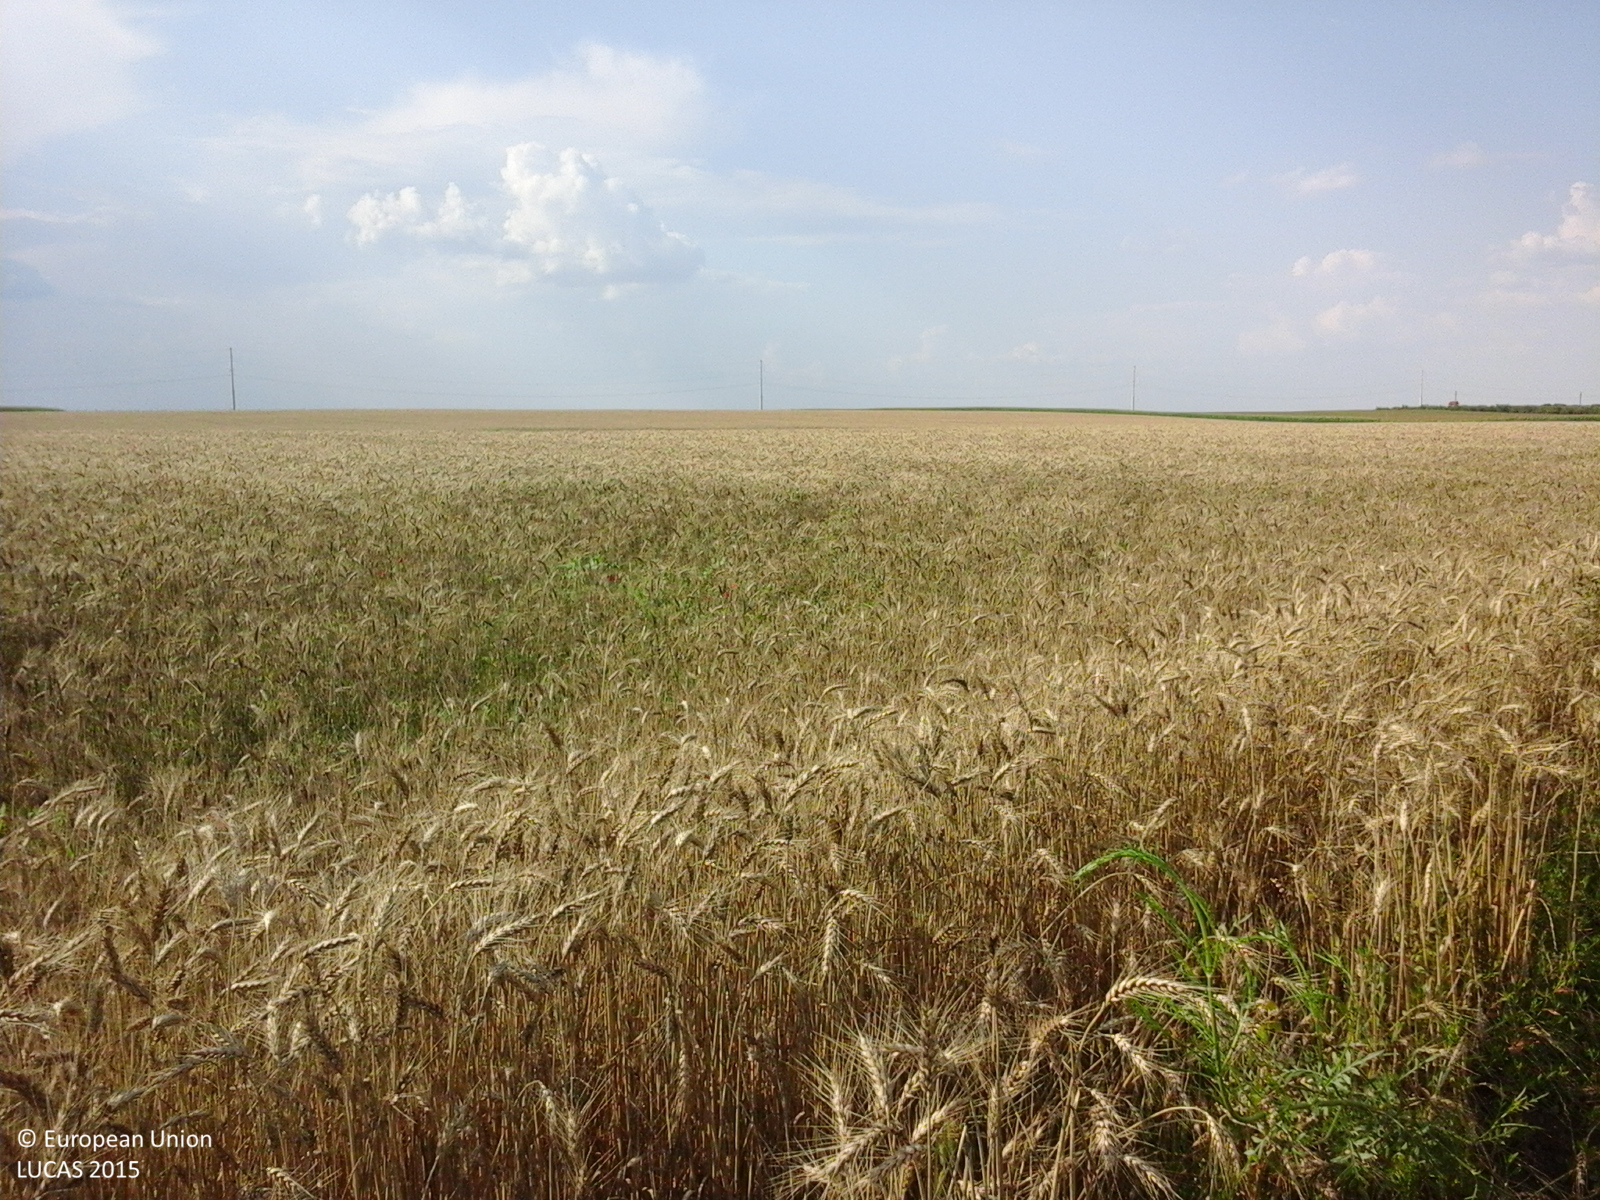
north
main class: Cropland
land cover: Common wheat
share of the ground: > 75 %
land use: Agriculture (excluding fallow land and kitchen gardens)
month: July
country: RO
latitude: 43.8425
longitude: 25.8266
